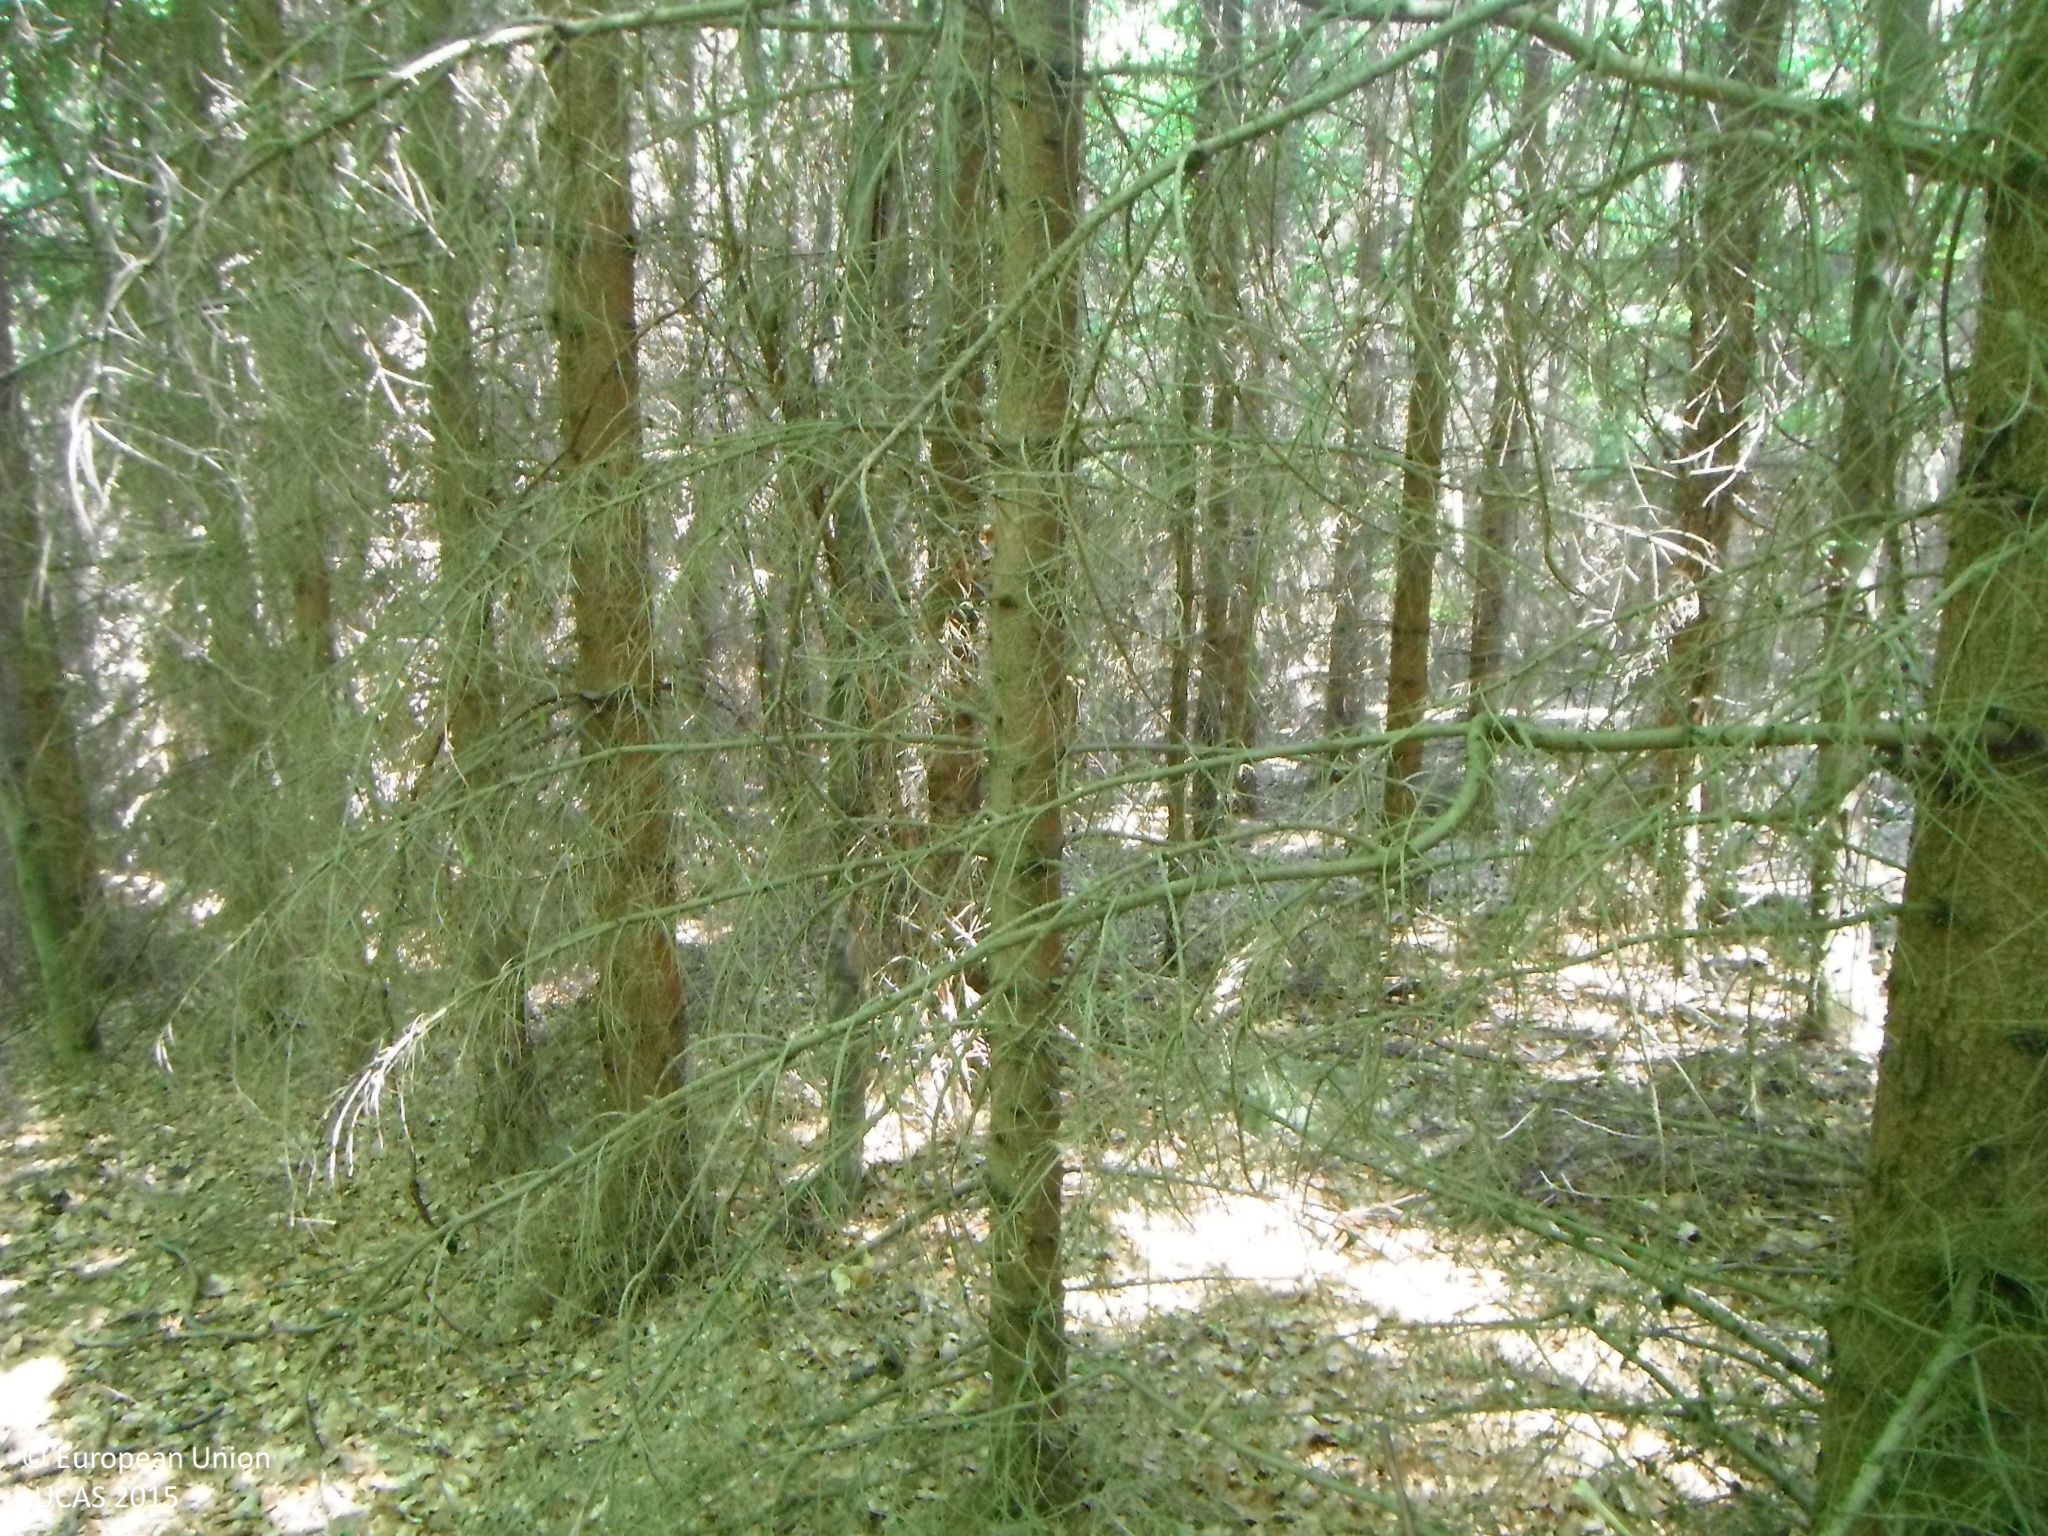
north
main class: Woodland
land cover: Spruce dominated mixed woodland
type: alpine coniferous forest
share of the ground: > 75 %
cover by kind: coniferous forest trees 50 %, broadleaved forest trees 50 %
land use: Forestry
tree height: > 5 m
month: July
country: SK
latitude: 48.5115
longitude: 19.1592
